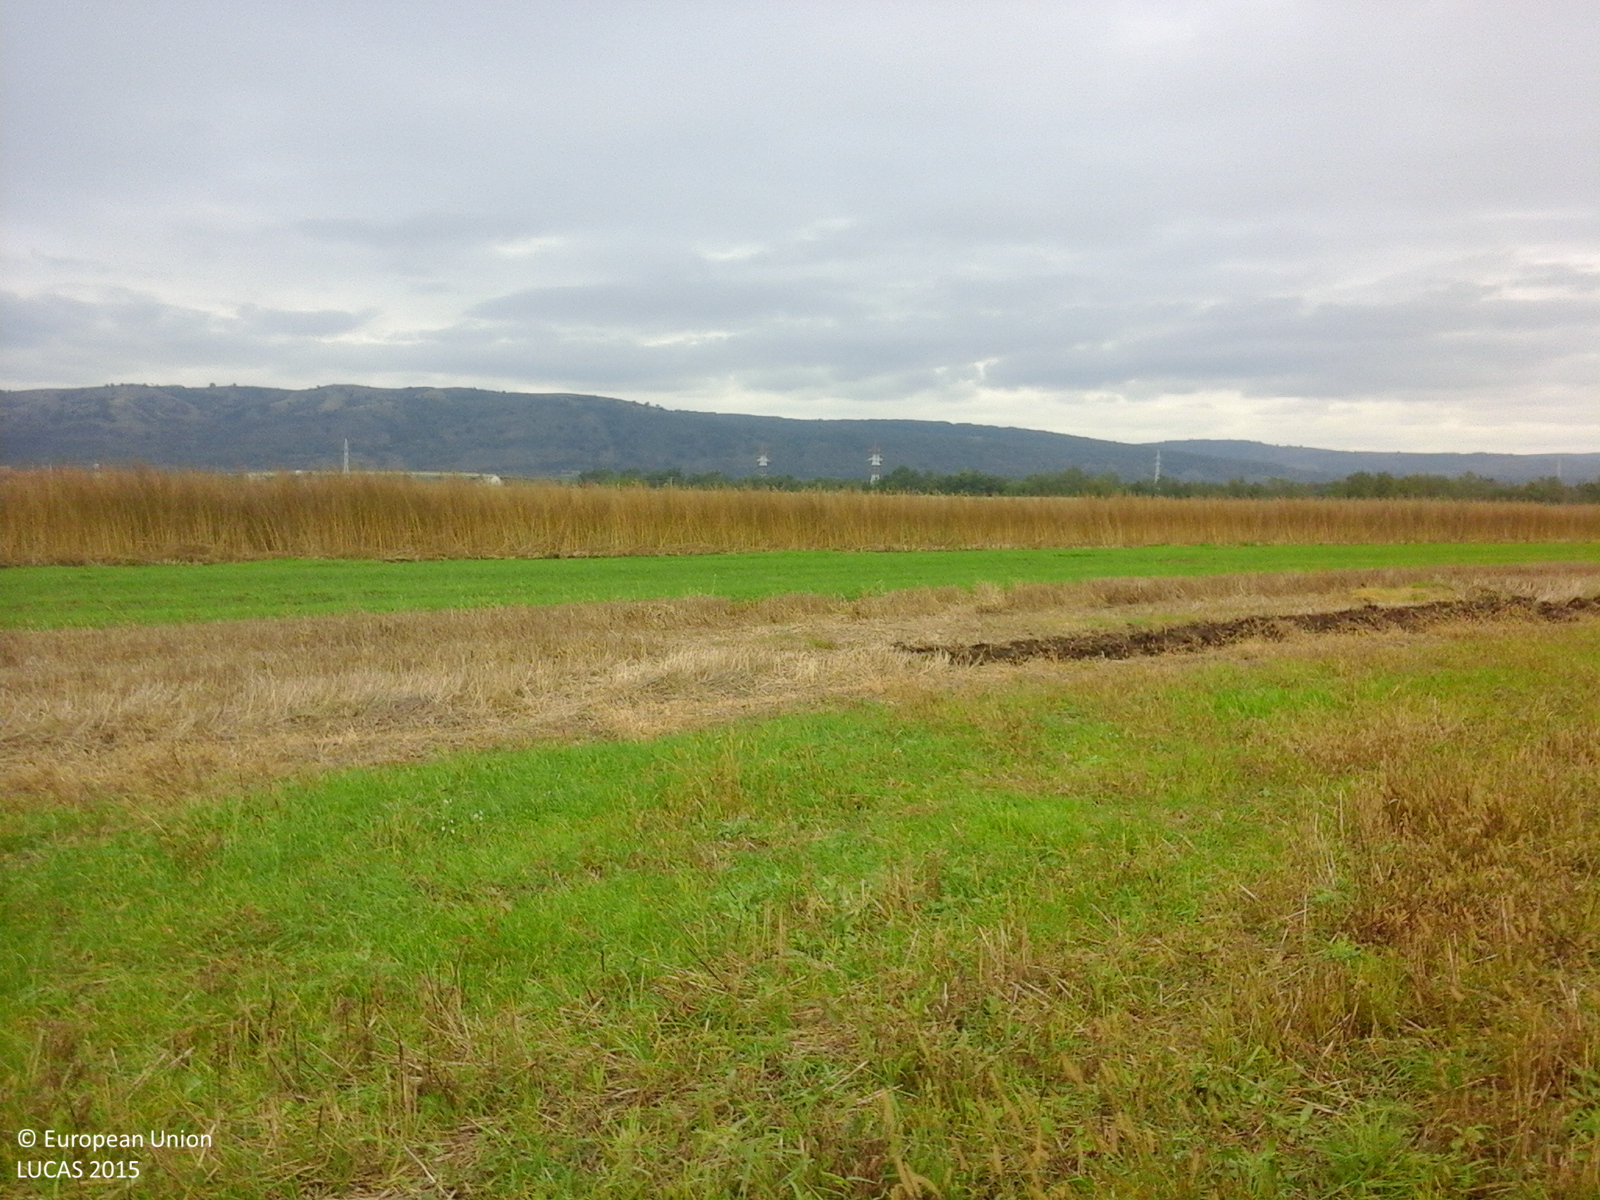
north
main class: Grassland
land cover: Spontaneously vegetated surfaces
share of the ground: > 75 %
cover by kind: herbaceous plants 100 %
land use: Agriculture (excluding fallow land and kitchen gardens)
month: October
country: RO
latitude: 45.8265
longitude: 24.9326
